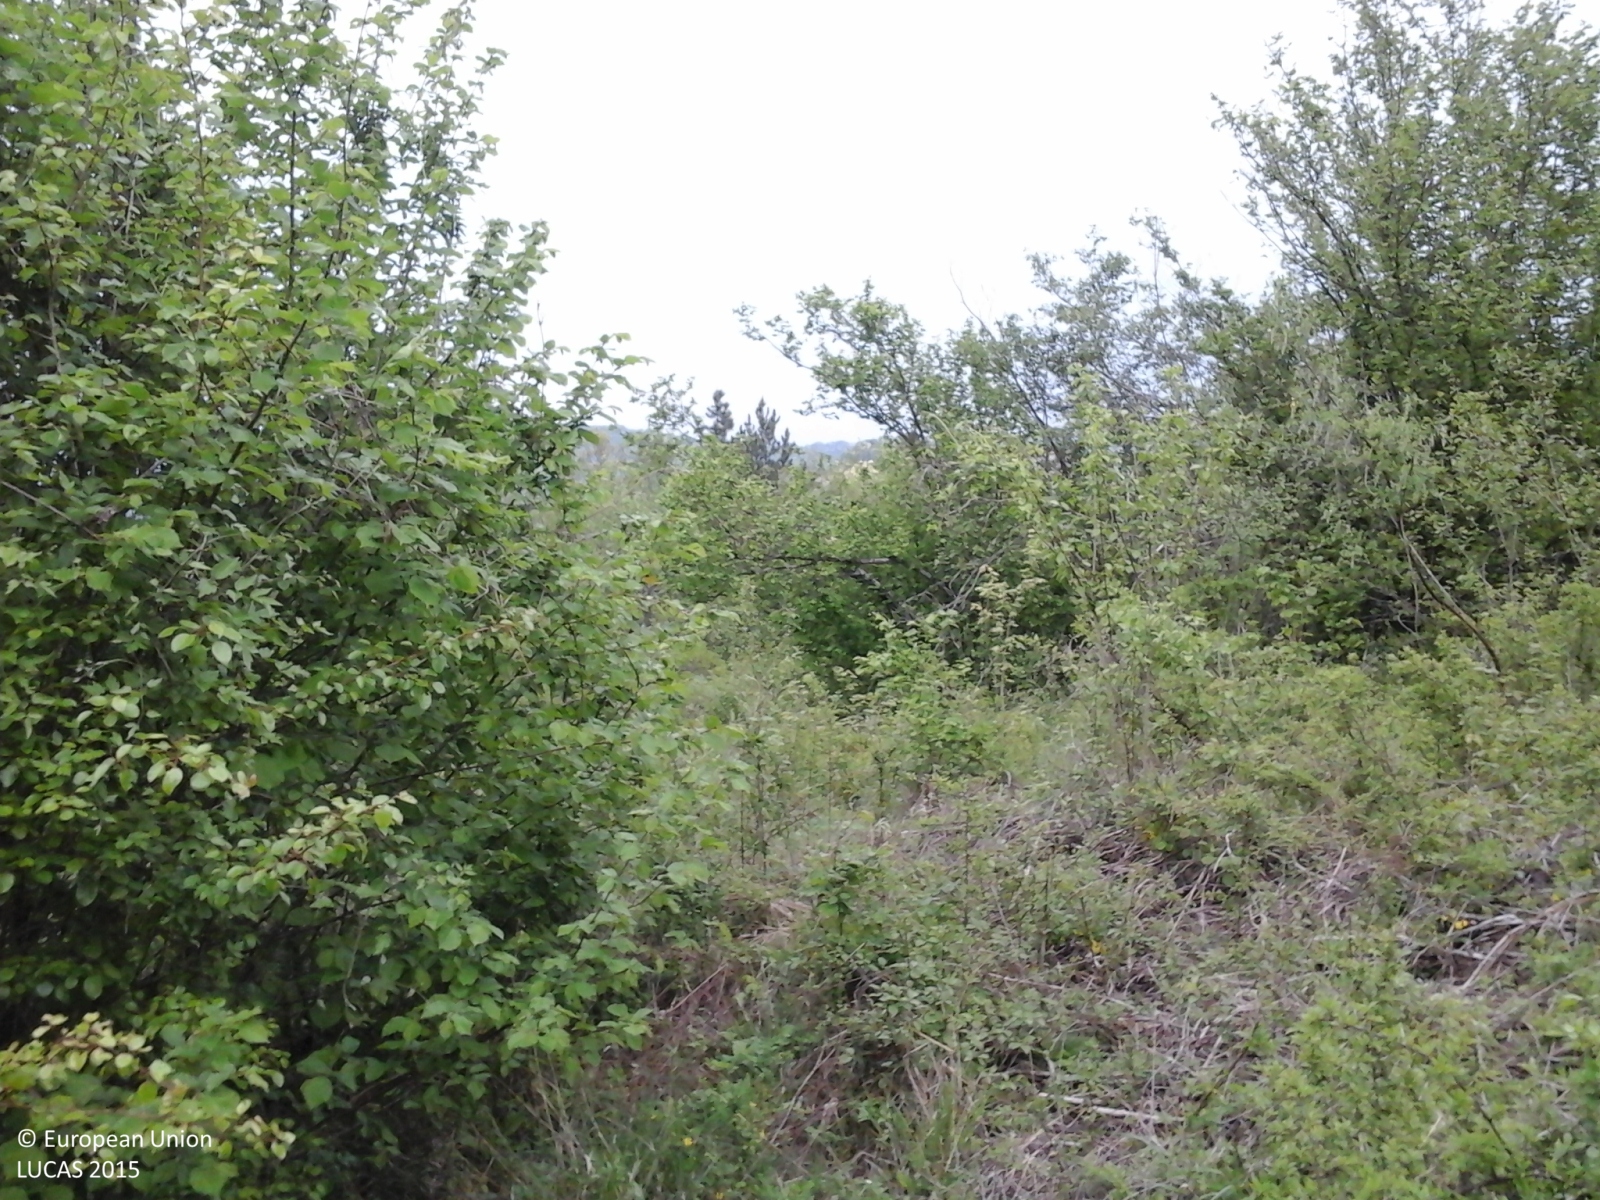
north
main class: Woodland
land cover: Broadleaved woodland
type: thermophilous deciduous forest
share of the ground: > 75 %
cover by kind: broadleaved forest trees 80 %, shrubs 15 %, herbaceous plants 5 %
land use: Forestry
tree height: > 5 m
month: May
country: IT
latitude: 44.6915
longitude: 9.4082
